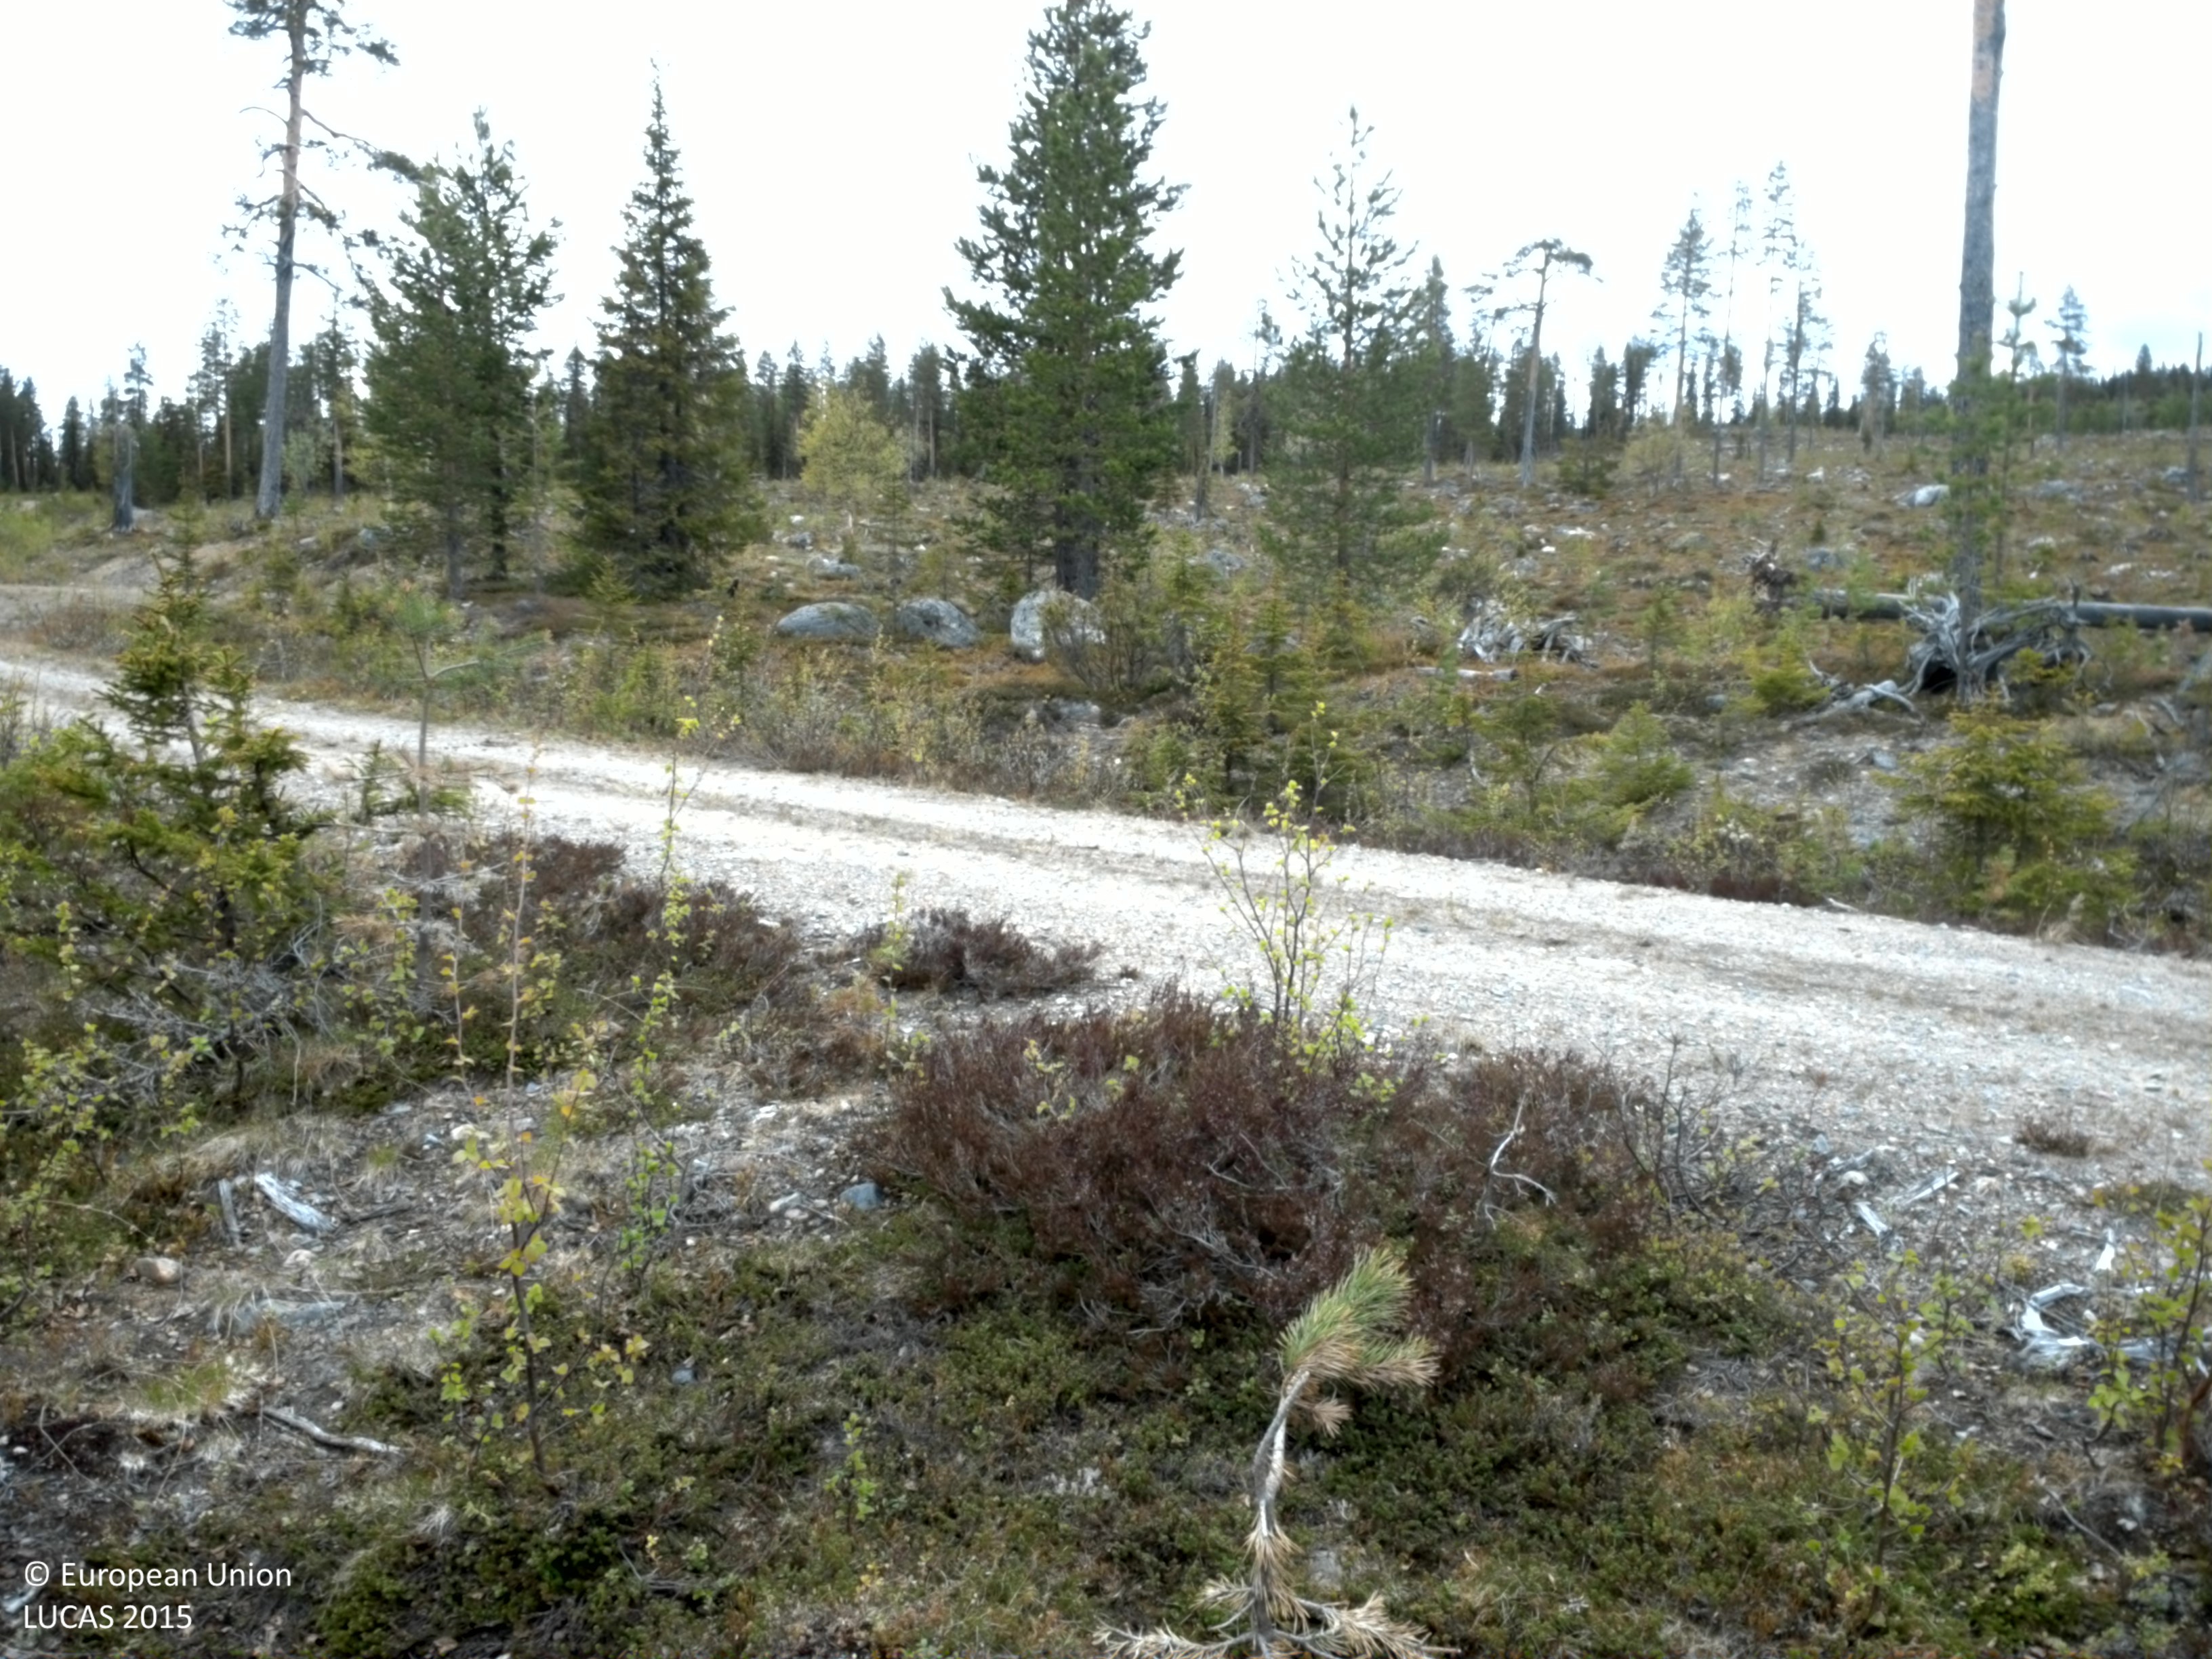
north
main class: Shrubland
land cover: Shrubland with sparse tree cover
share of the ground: > 75 %
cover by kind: shrubs 85 %, herbaceous plants 10 %, coniferous forest trees 5 %
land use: Forestry
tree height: < 5 m
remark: Clear cut
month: June
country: SE
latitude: 66.0399
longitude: 18.5839
